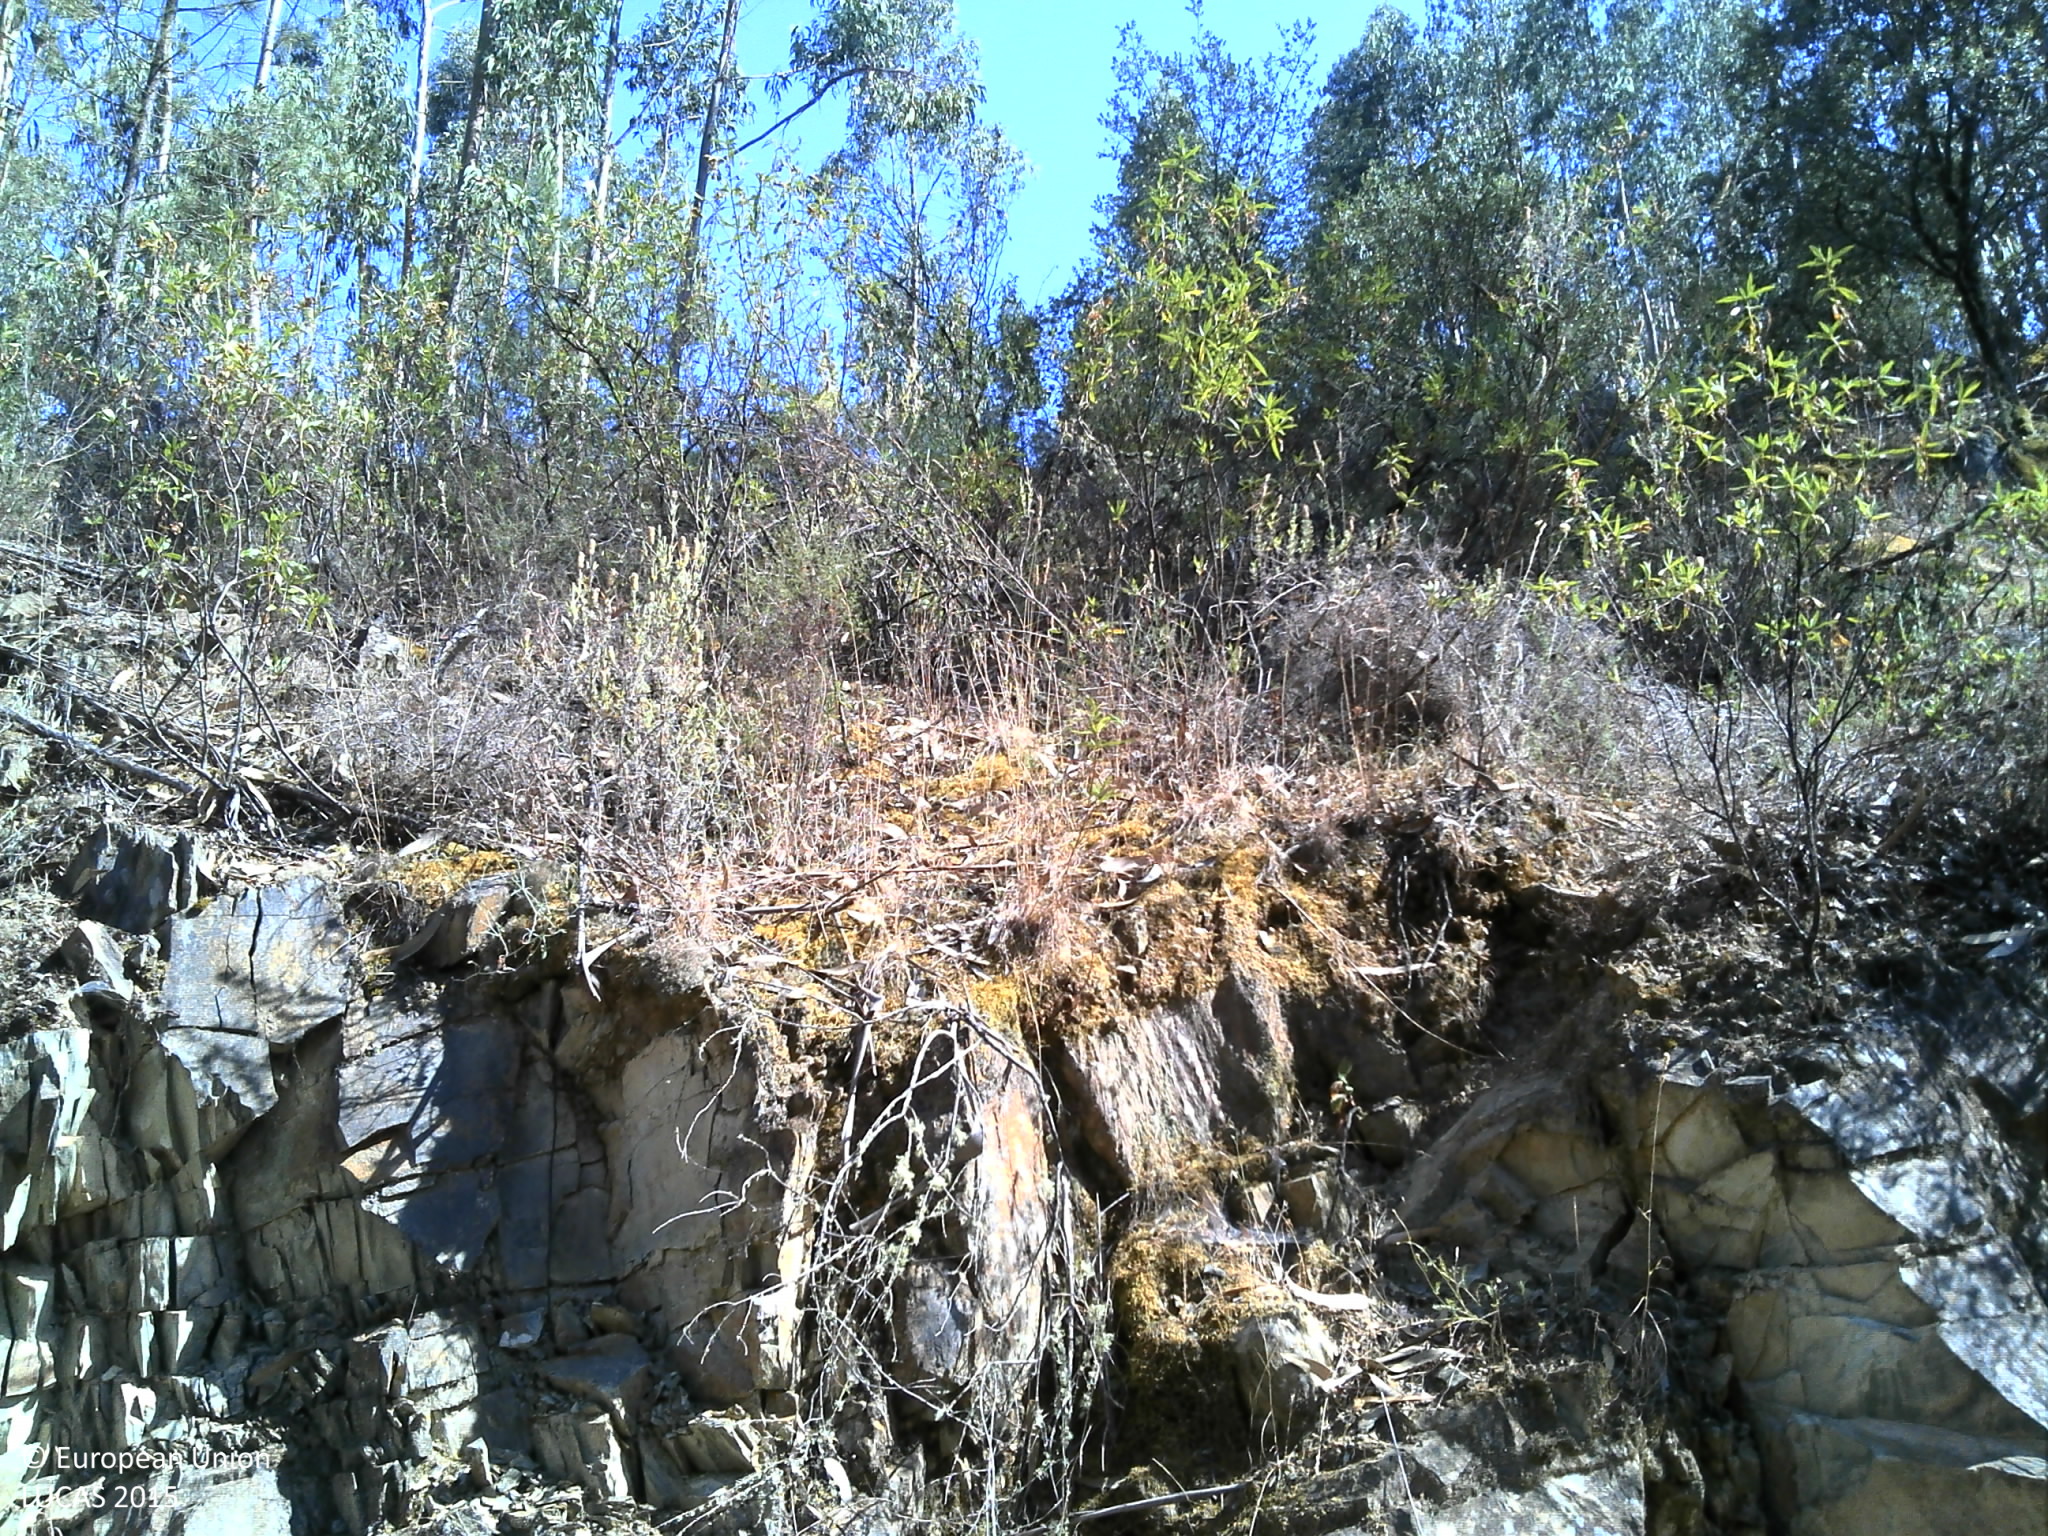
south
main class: Woodland
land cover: Broadleaved woodland
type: exotic forest
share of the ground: 10 - 25 %
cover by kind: unconsolidated bare surface 50 %, consolidated bare surface 20 %, broadleaved forest trees 15 %, shrubs 15 %
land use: Forestry
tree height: > 5 m
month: July
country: PT
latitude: 39.5875
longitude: -7.7886
